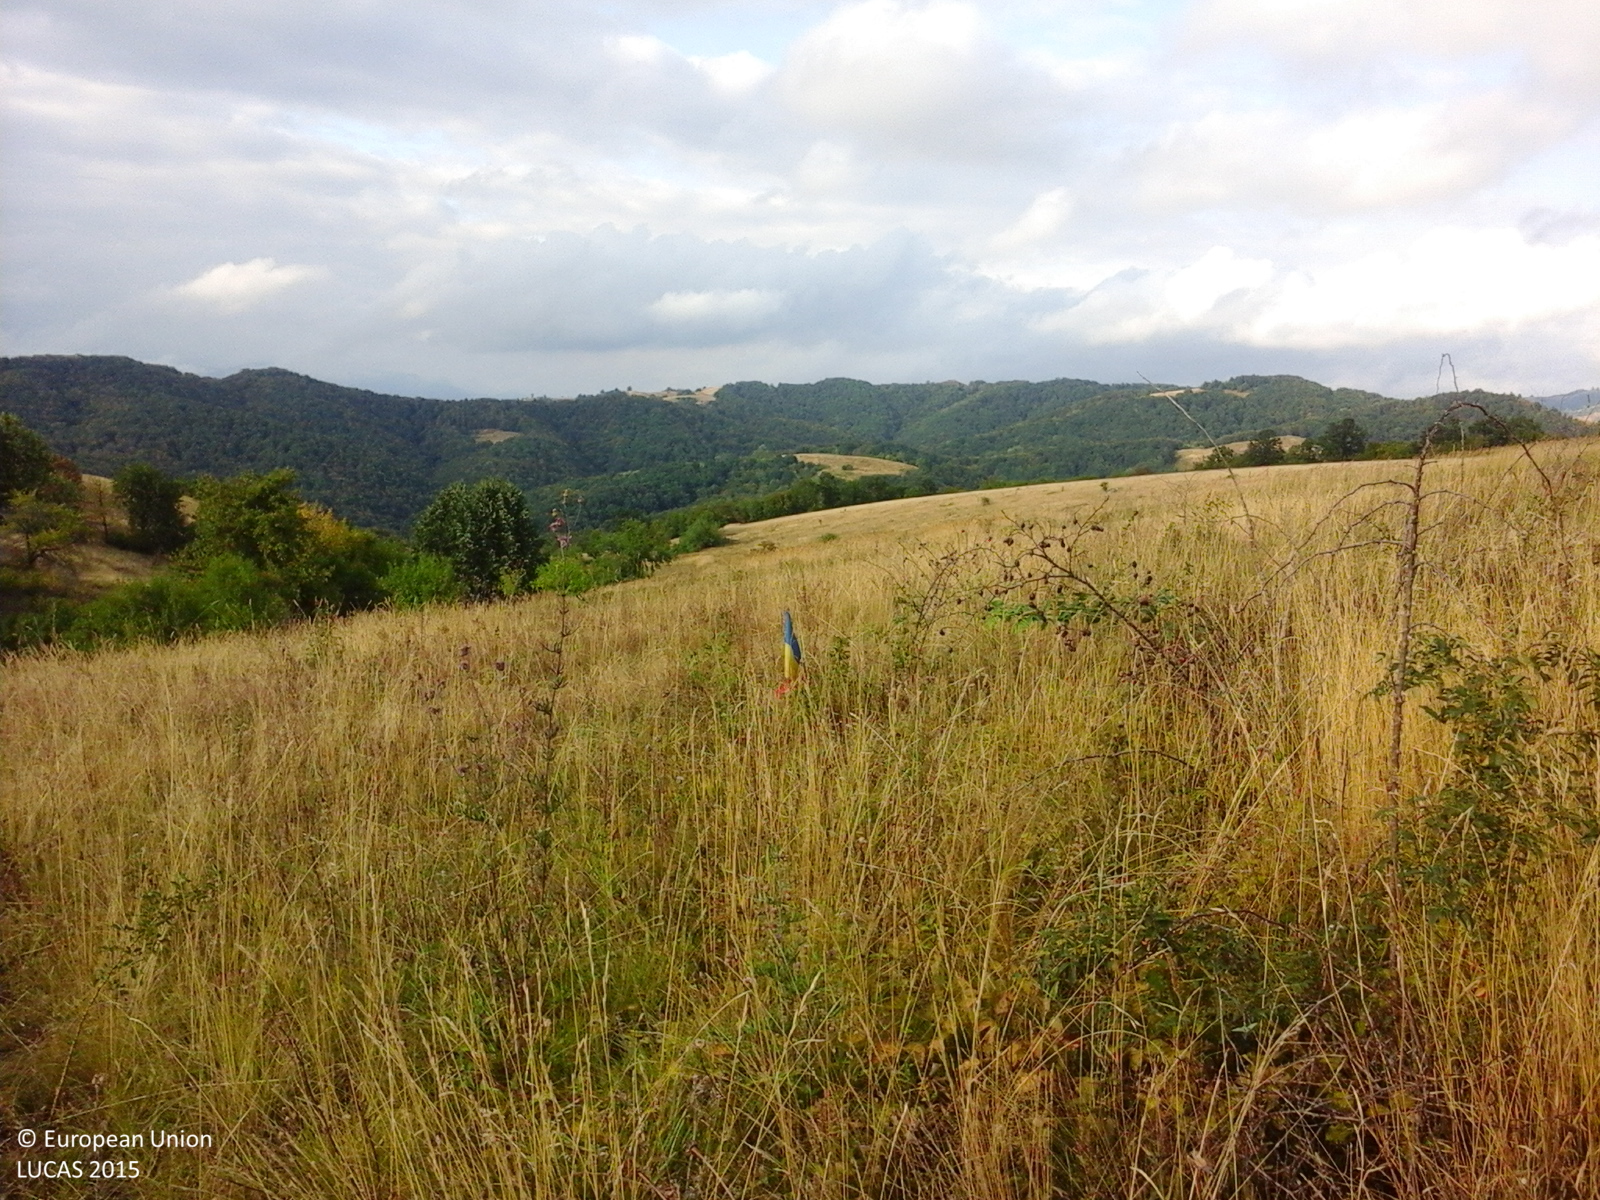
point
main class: Grassland
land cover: Spontaneously vegetated surfaces
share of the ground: > 75 %
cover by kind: herbaceous plants 100 %
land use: Fallow land
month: August
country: RO
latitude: 44.7473
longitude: 21.8155
